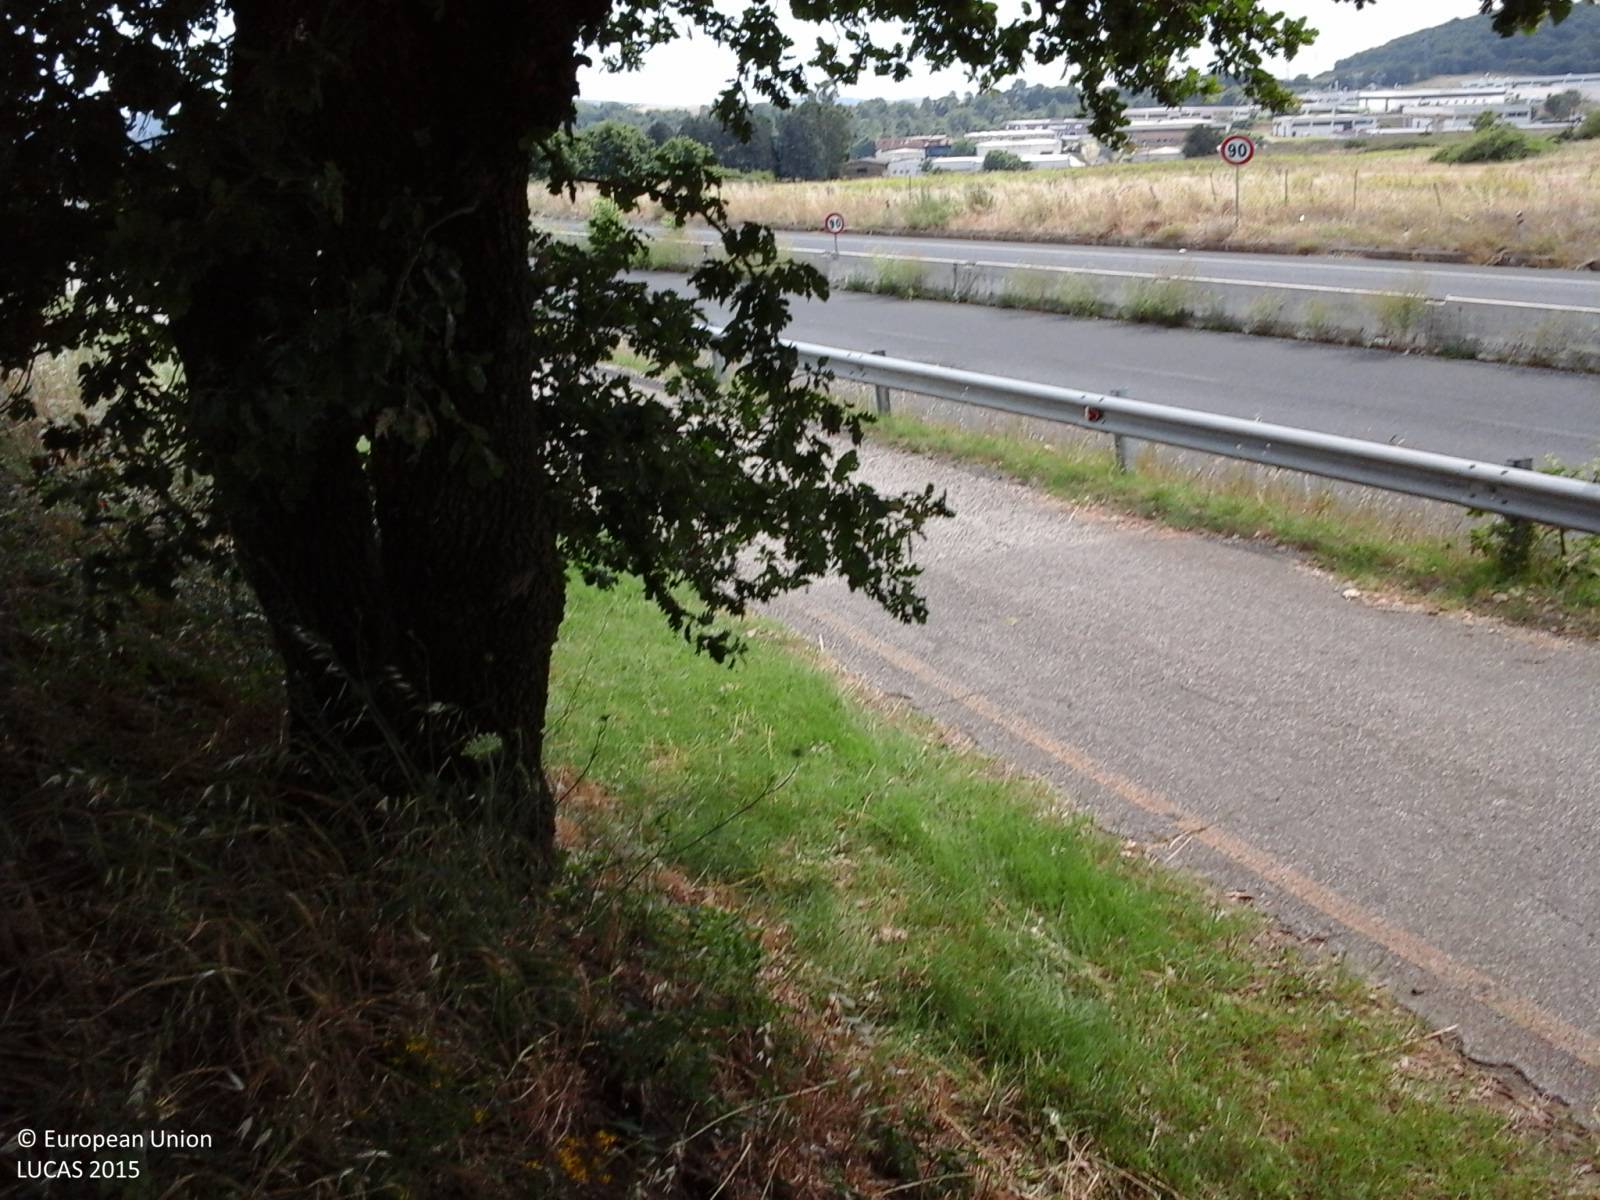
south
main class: Cropland
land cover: Durum wheat
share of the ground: > 75 %
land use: Agriculture (excluding fallow land and kitchen gardens)
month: June
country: IT
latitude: 42.1755
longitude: 12.3282
